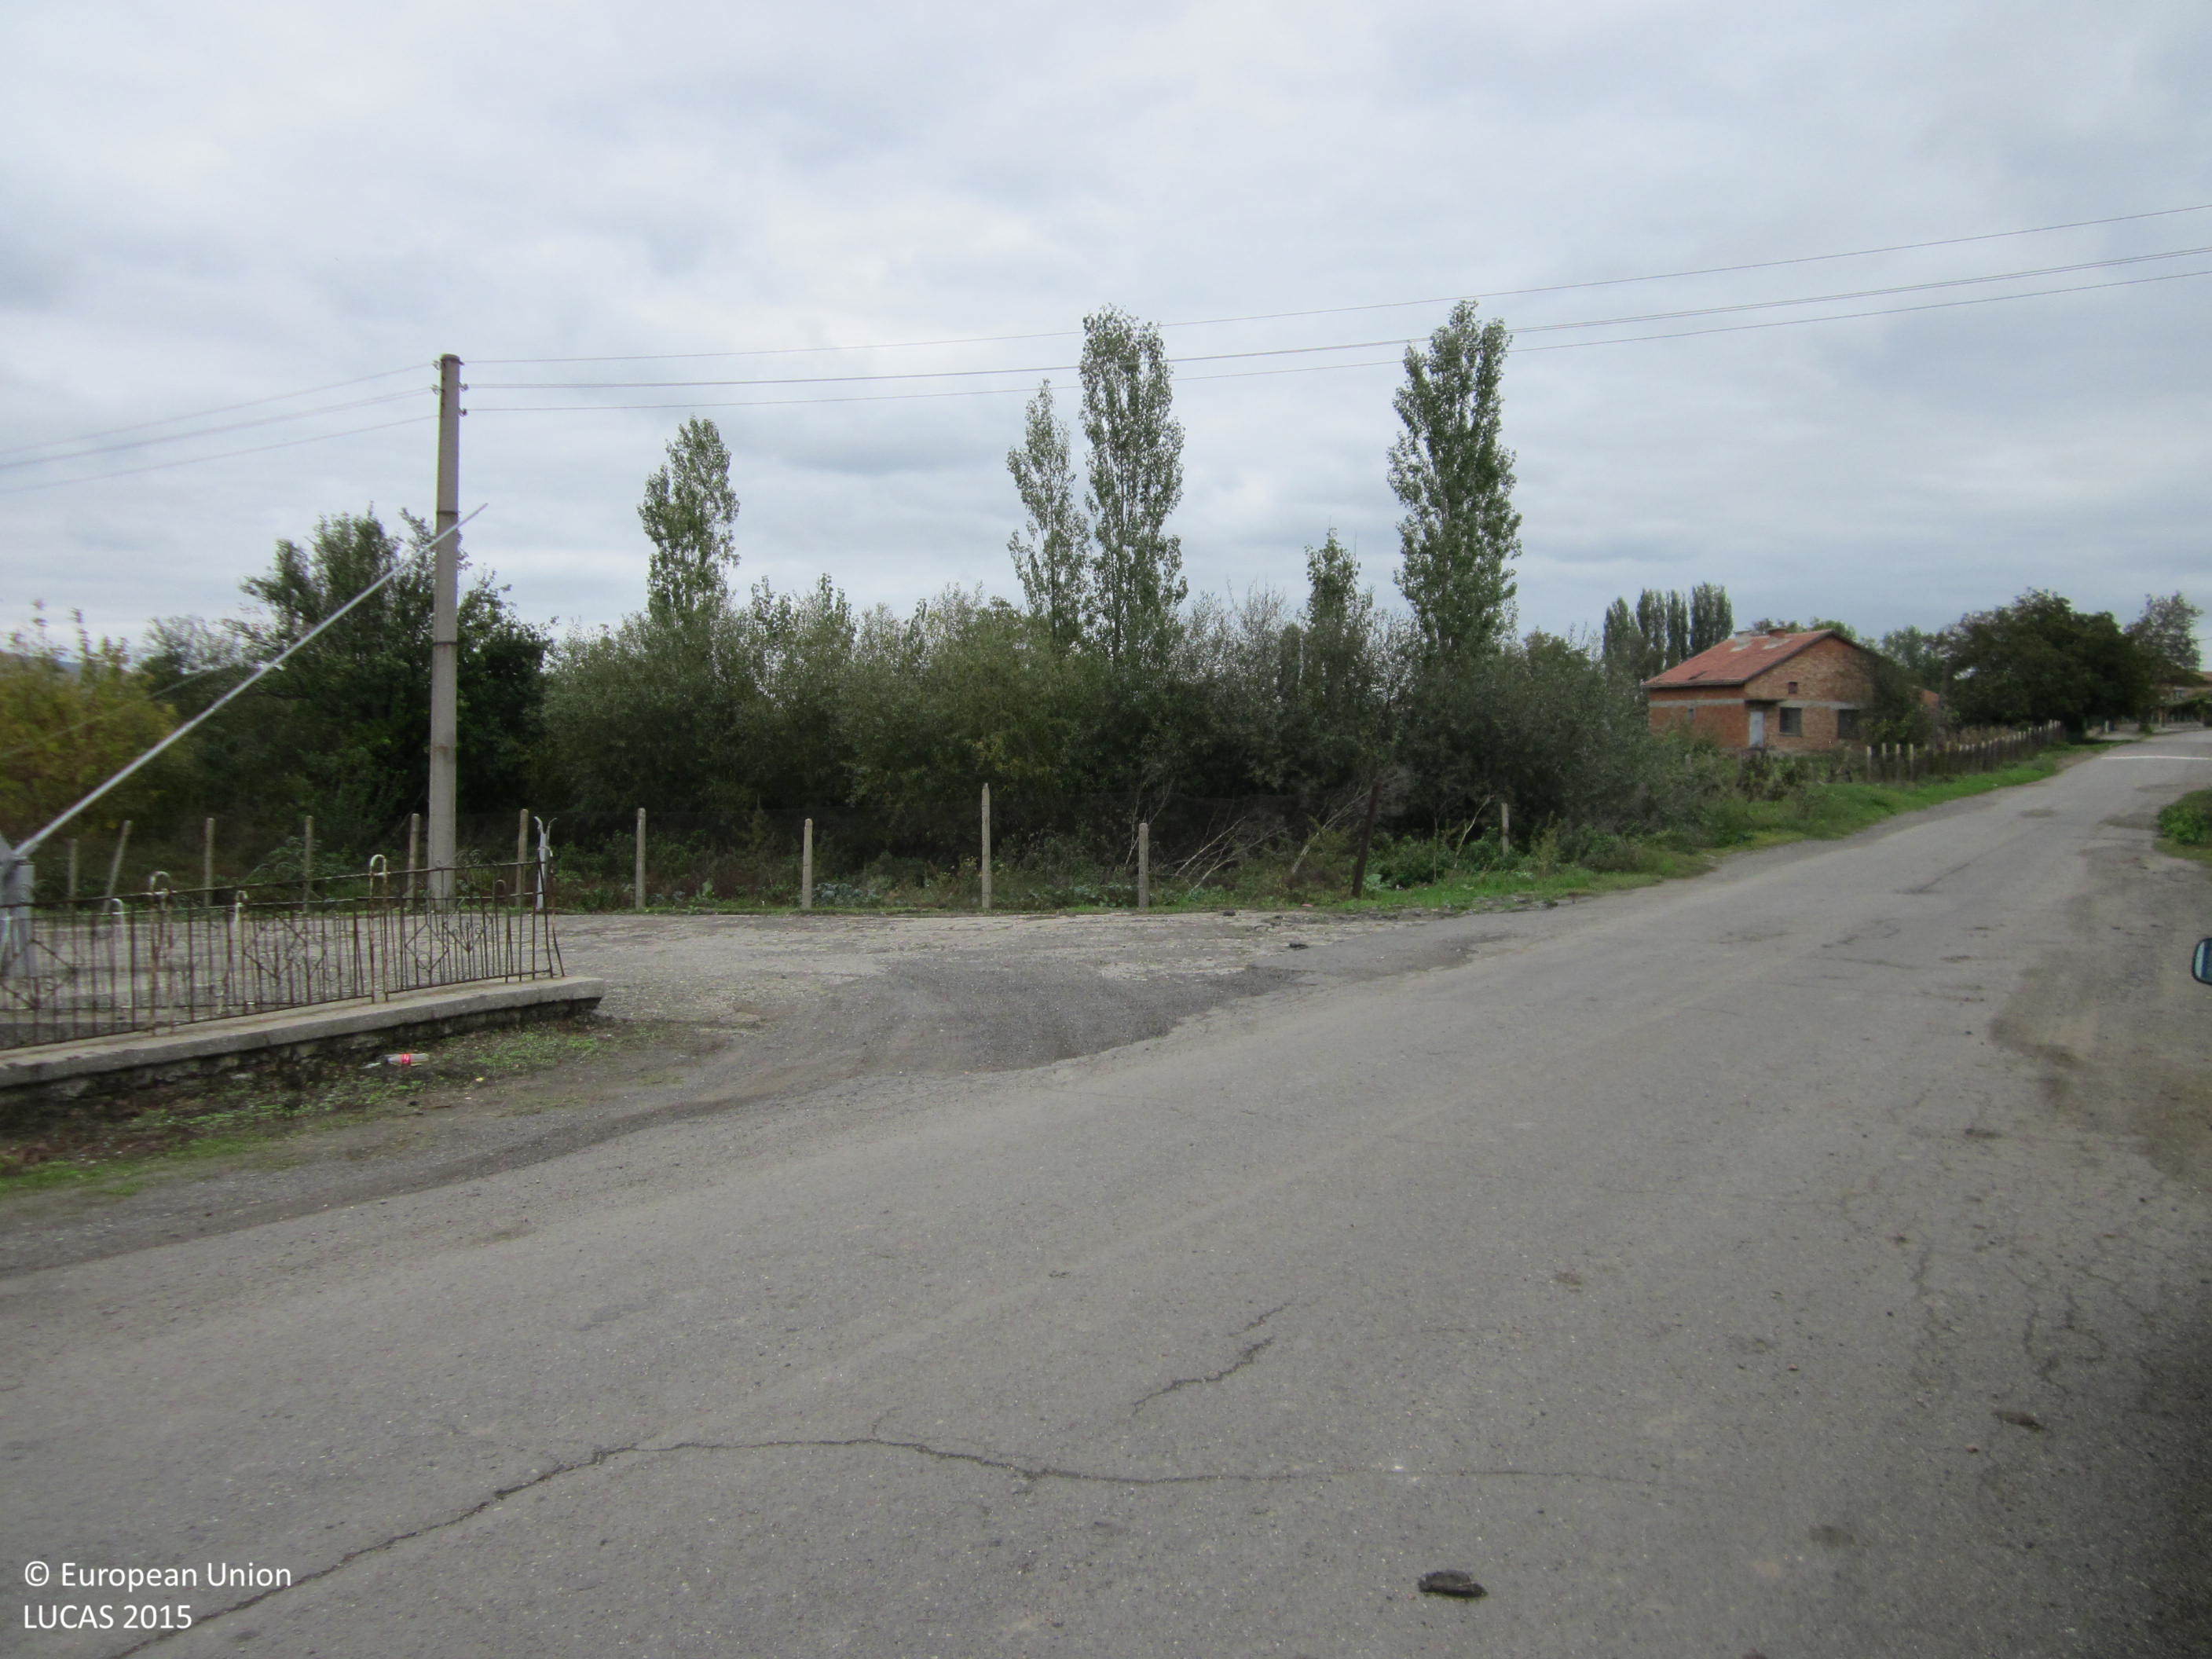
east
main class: Grassland
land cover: Spontaneously vegetated surfaces
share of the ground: > 75 %
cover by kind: herbaceous plants 100 %
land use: Fallow land
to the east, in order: Spontaneously vegetated surfaces; Artificial constructions in urban areas
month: October
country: BG
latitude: 42.7165
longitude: 27.0951
